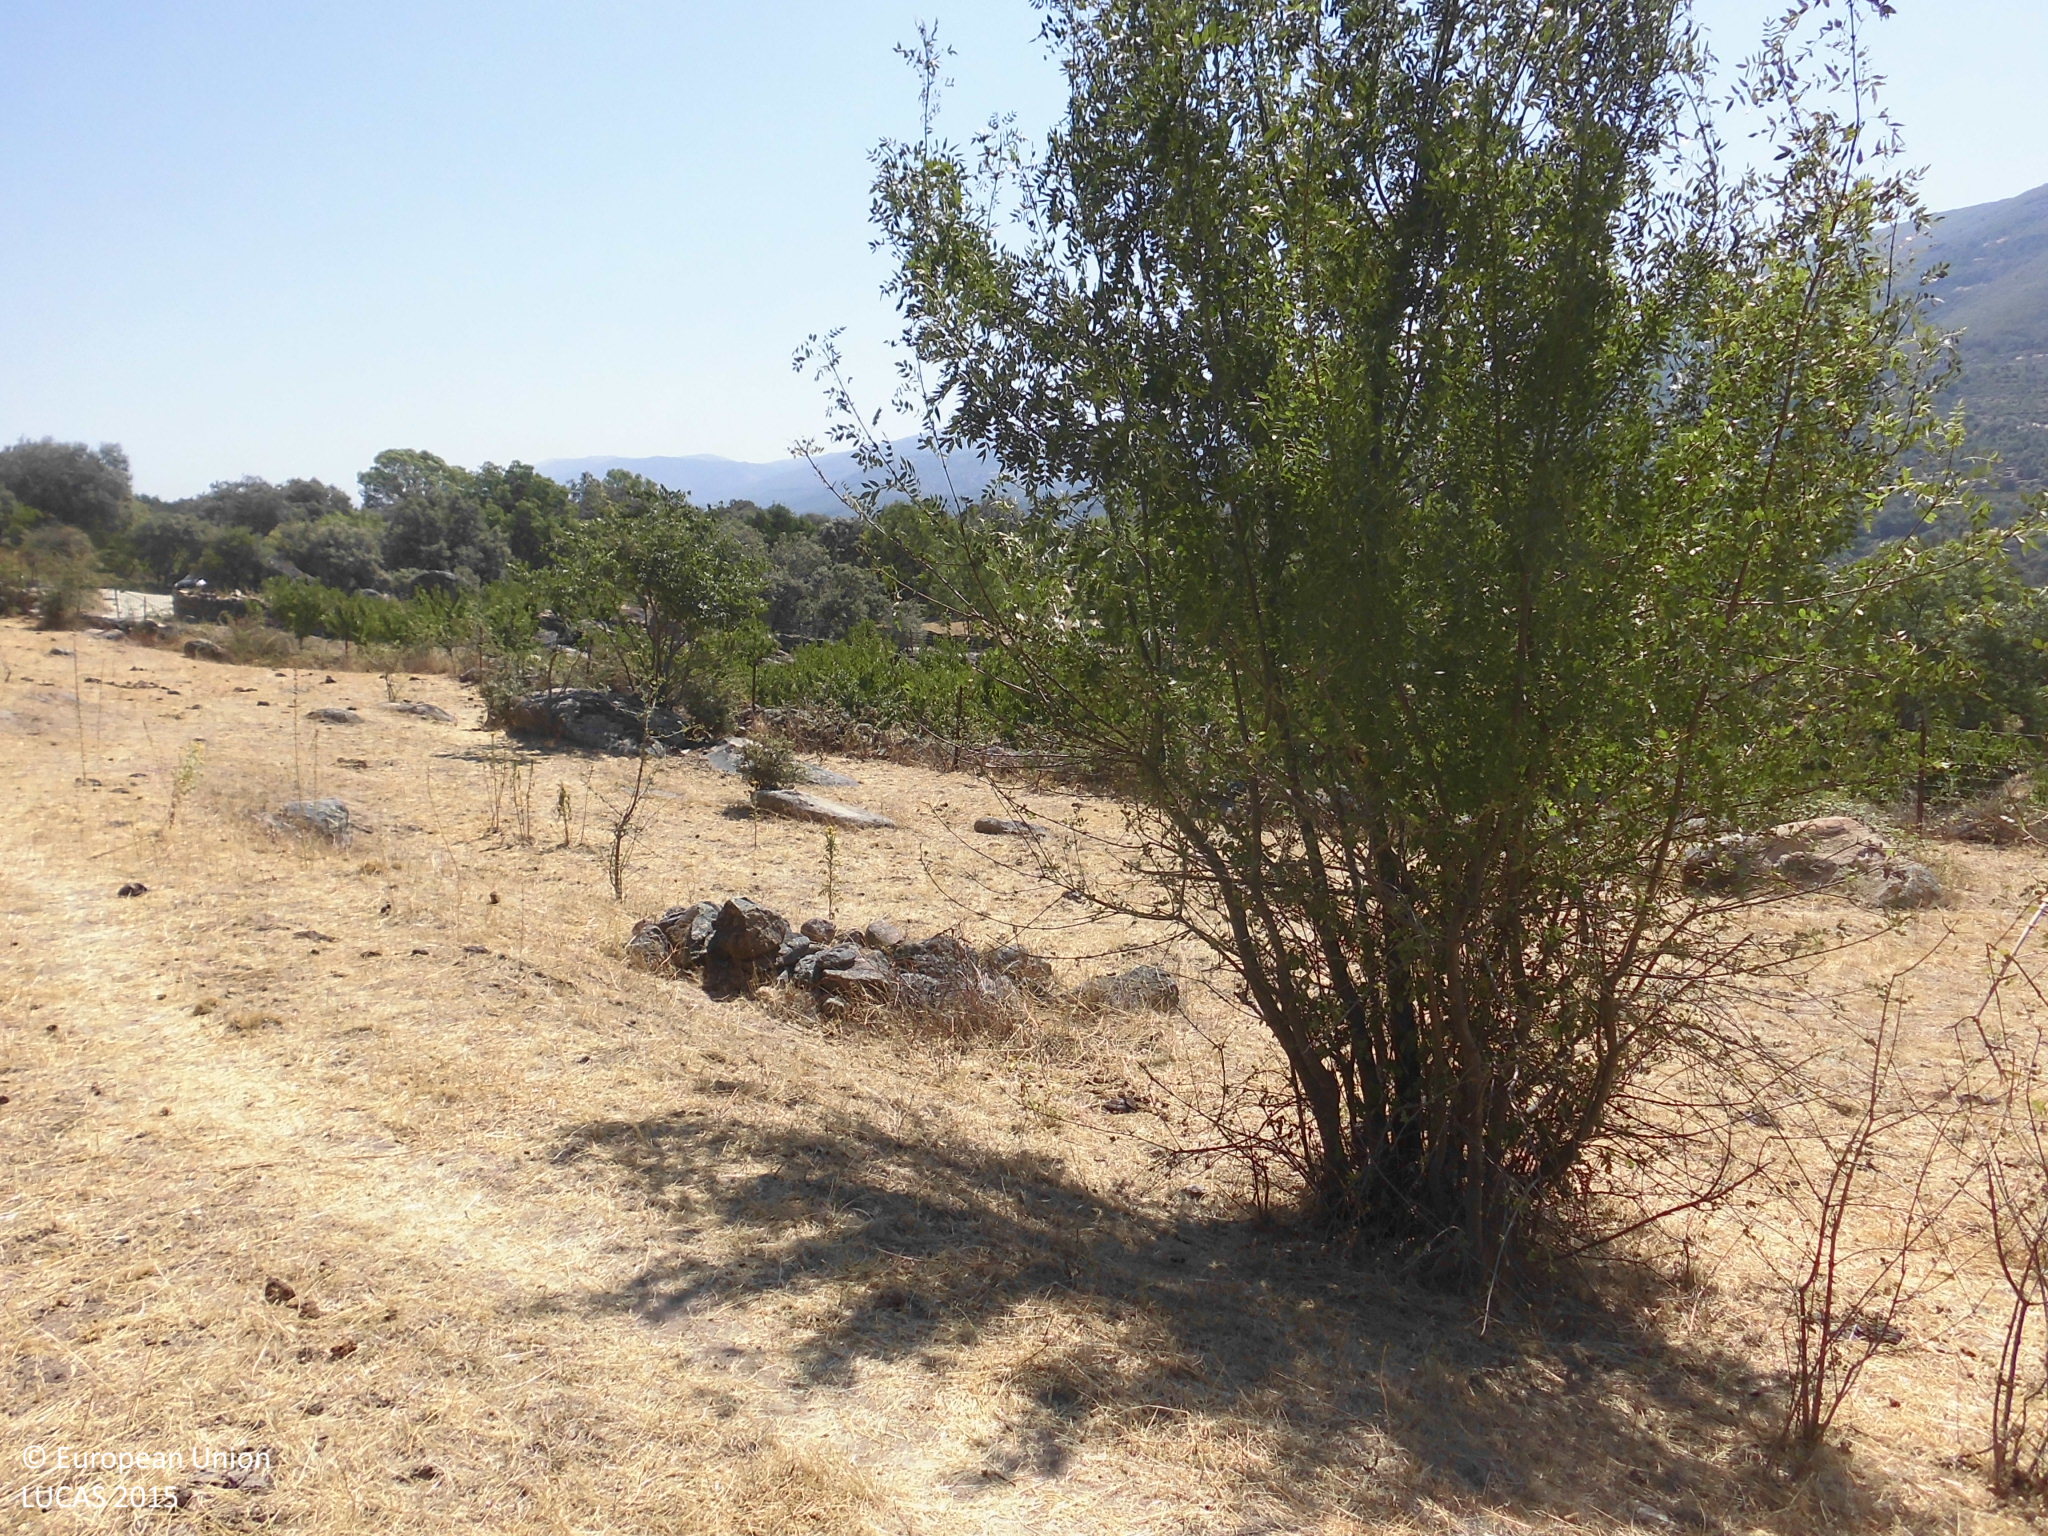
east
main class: Woodland
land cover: Broadleaved woodland
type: thermophilous deciduous forest
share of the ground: 10 - 25 %
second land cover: Grassland without tree/shrub cover
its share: > 75 %
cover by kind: herbaceous plants 90 %, broadleaved forest trees 10 %
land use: Forestry
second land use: Agriculture (excluding fallow land and kitchen gardens)
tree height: > 5 m
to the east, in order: Broadleaved woodland; Grassland without tree/shrub cover; Dry stone walls; Cherry fruit; Dry stone walls; Tracks; Dry stone walls; Cherry fruit; Groves; Dry stone walls; Grassland with sparse tree/shrub cover; Dry stone walls; Broadleaved woodland; Fences; Cherry fruit
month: July
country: ES
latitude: 40.1093
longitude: -5.9672
